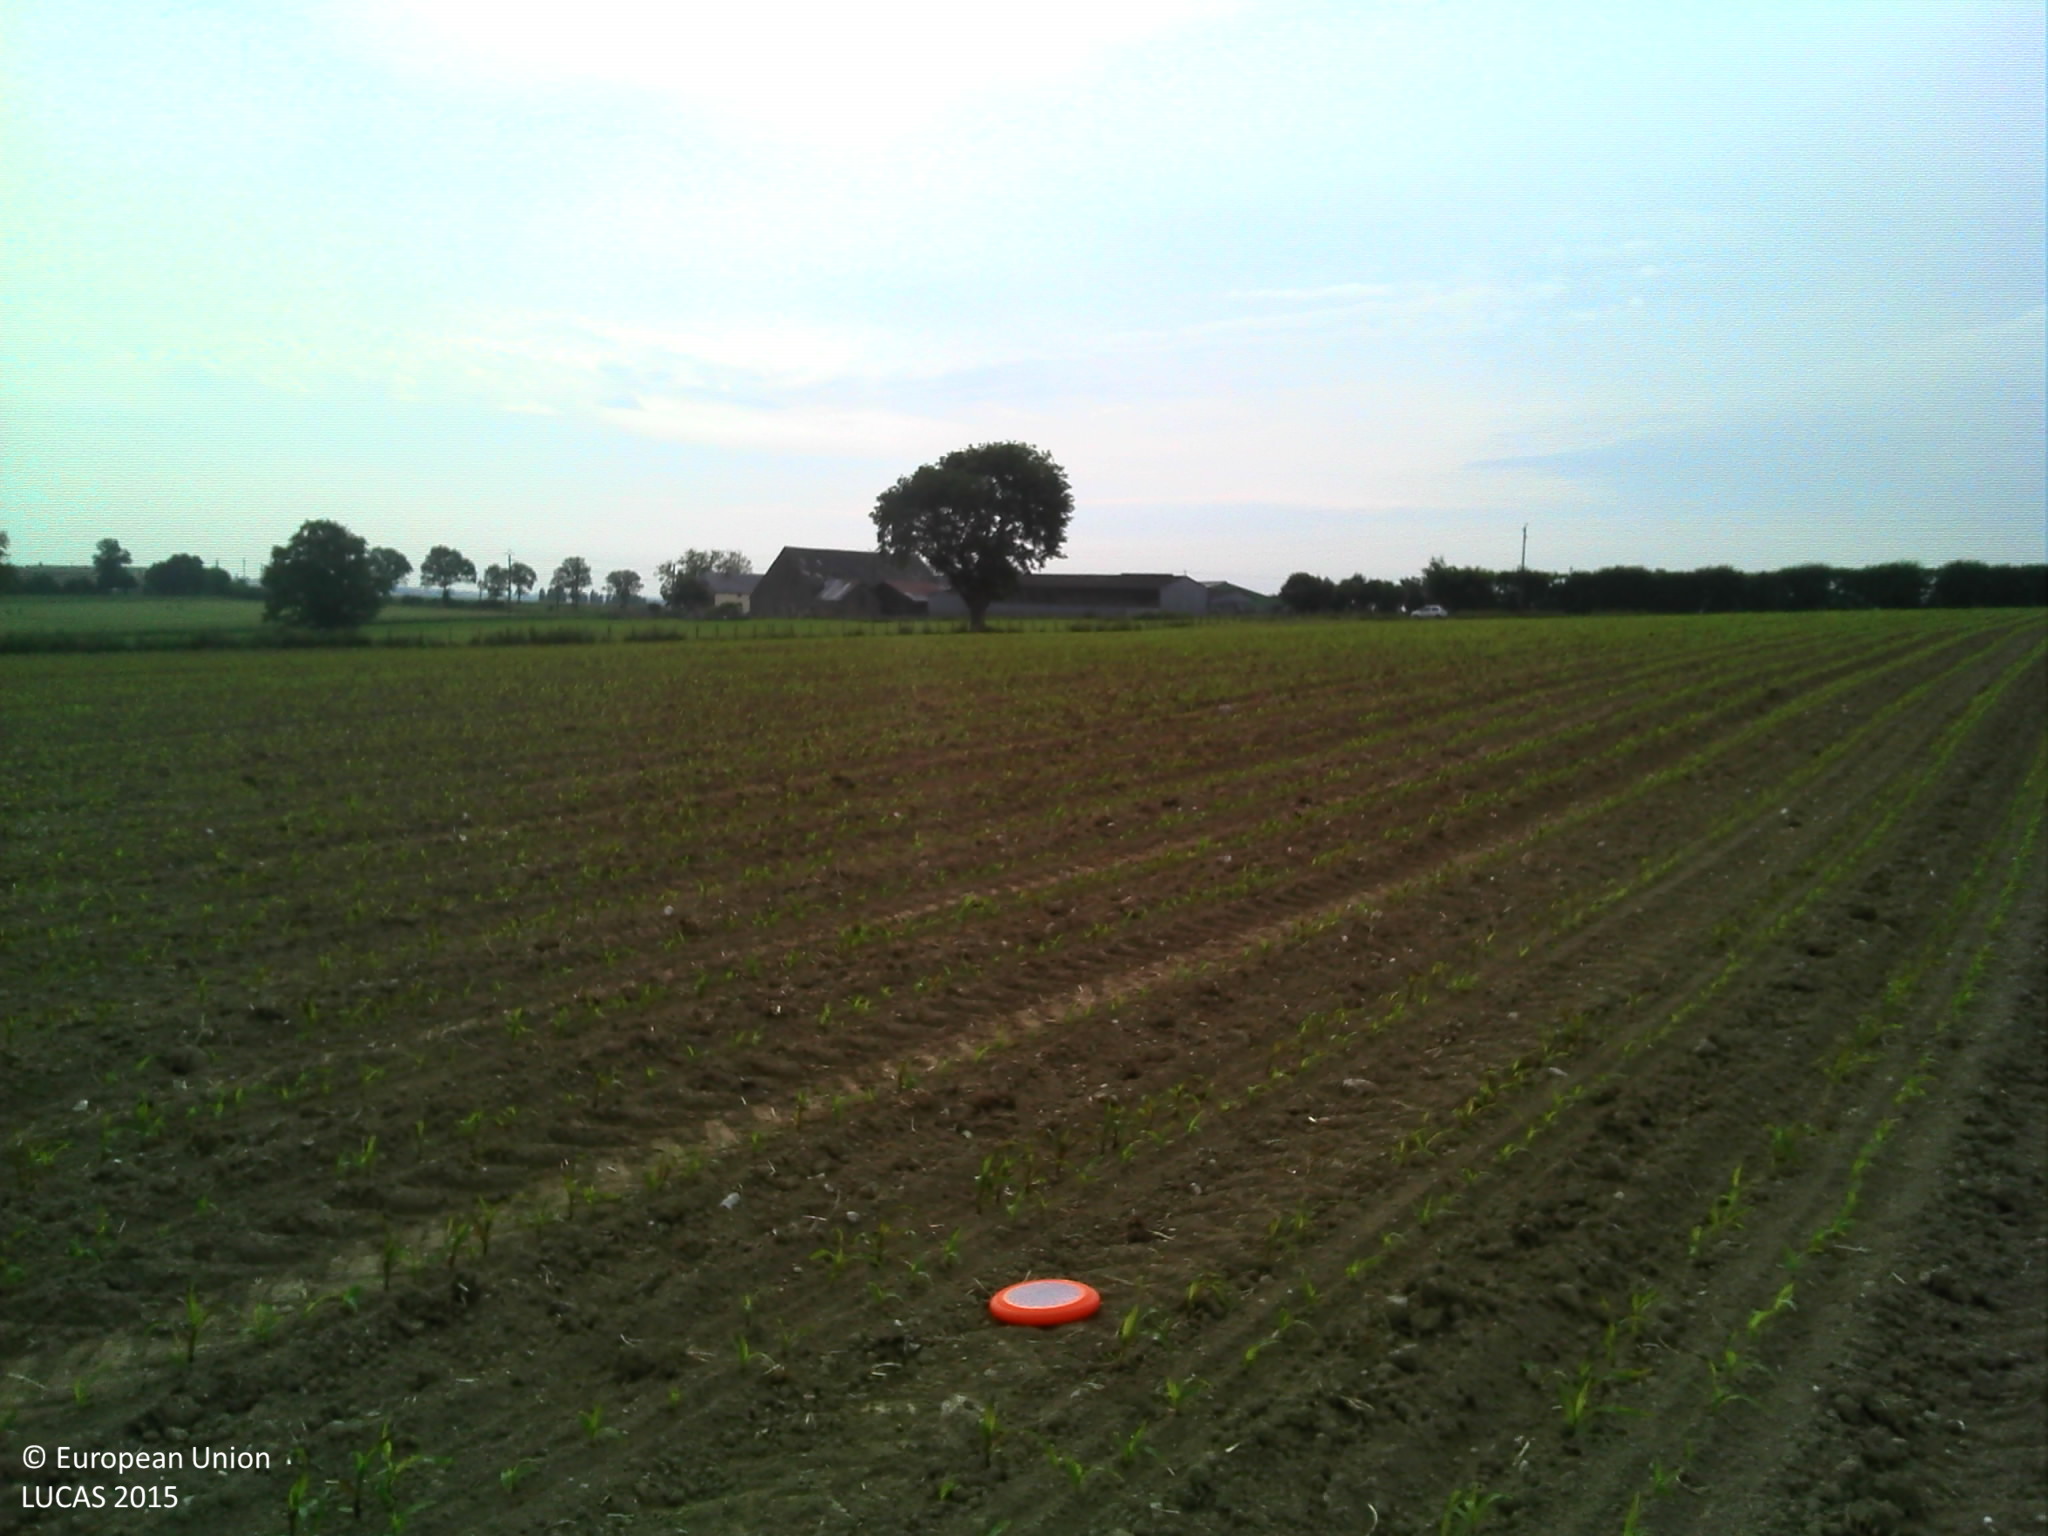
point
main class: Cropland
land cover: Maize
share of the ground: 10 - 25 %
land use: Agriculture (excluding fallow land and kitchen gardens)
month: June
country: FR
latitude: 48.3024
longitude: -0.1006
